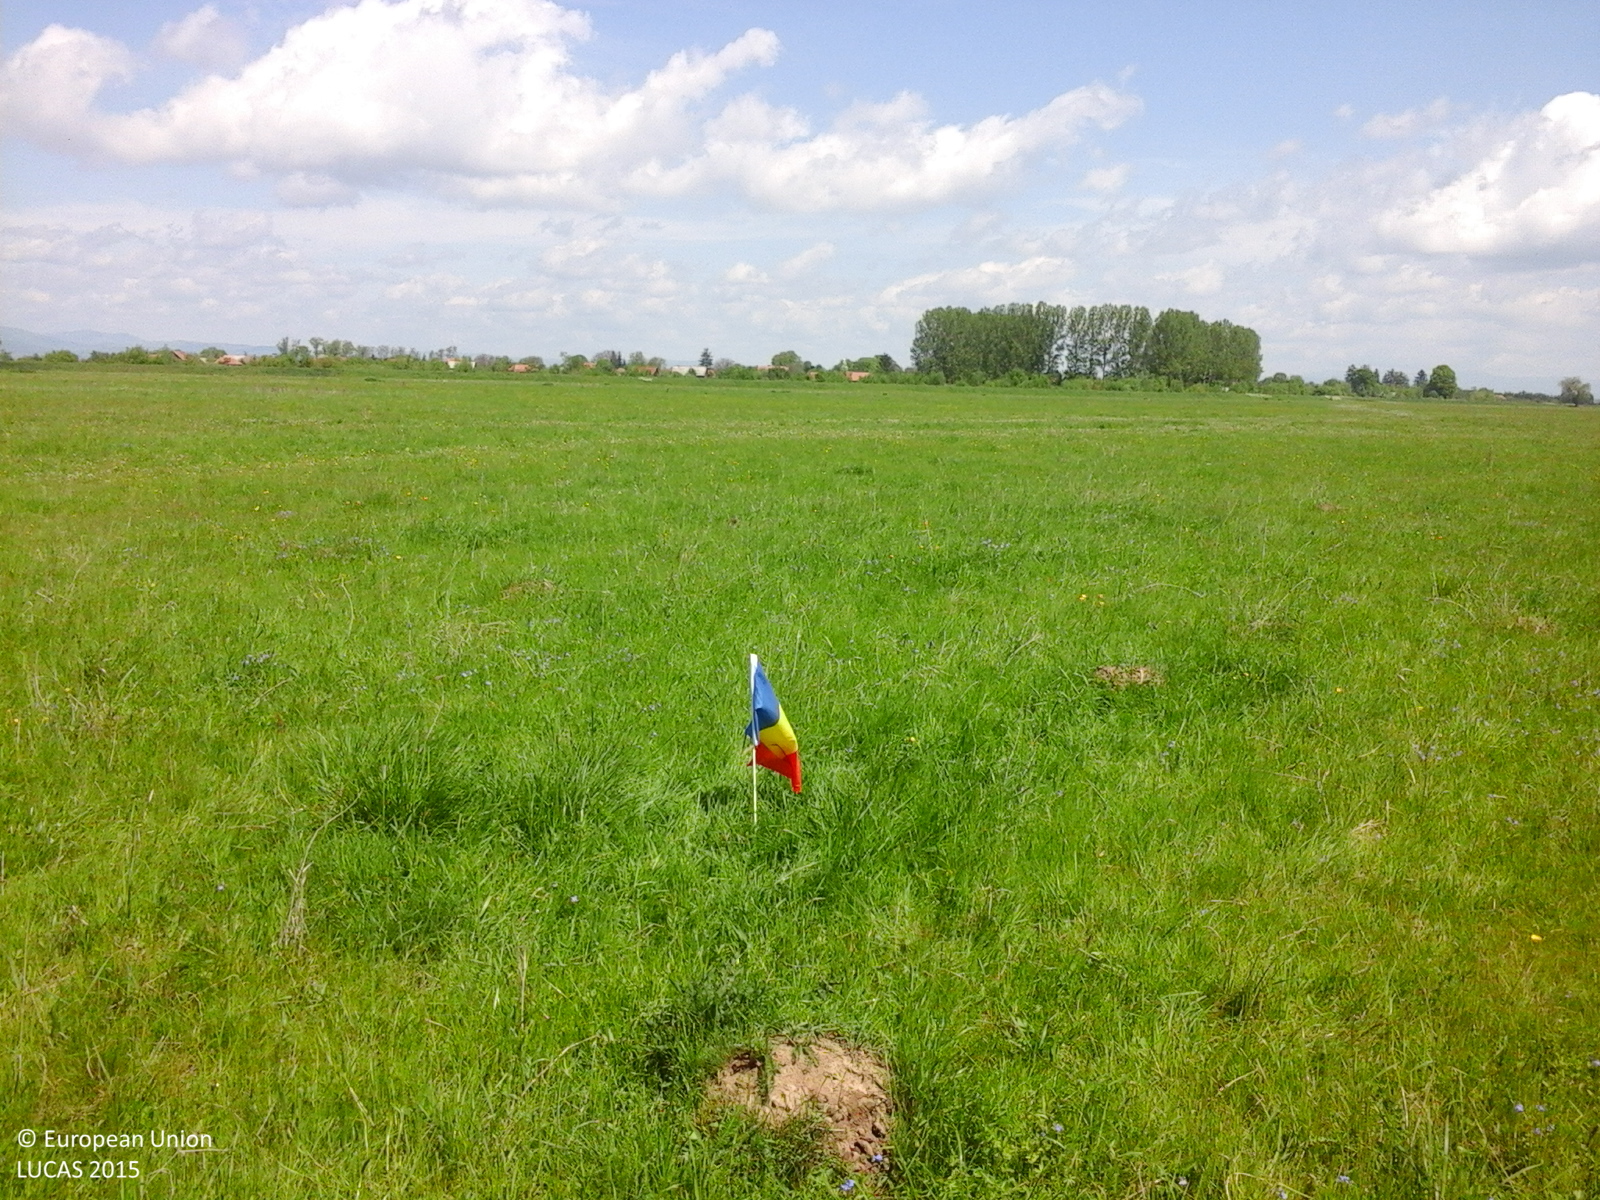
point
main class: Grassland
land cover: Grassland without tree/shrub cover
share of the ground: > 75 %
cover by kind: herbaceous plants 95 %, consolidated bare surface 5 %
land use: Agriculture (excluding fallow land and kitchen gardens)
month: May
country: RO
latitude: 45.8164
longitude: 26.1157
